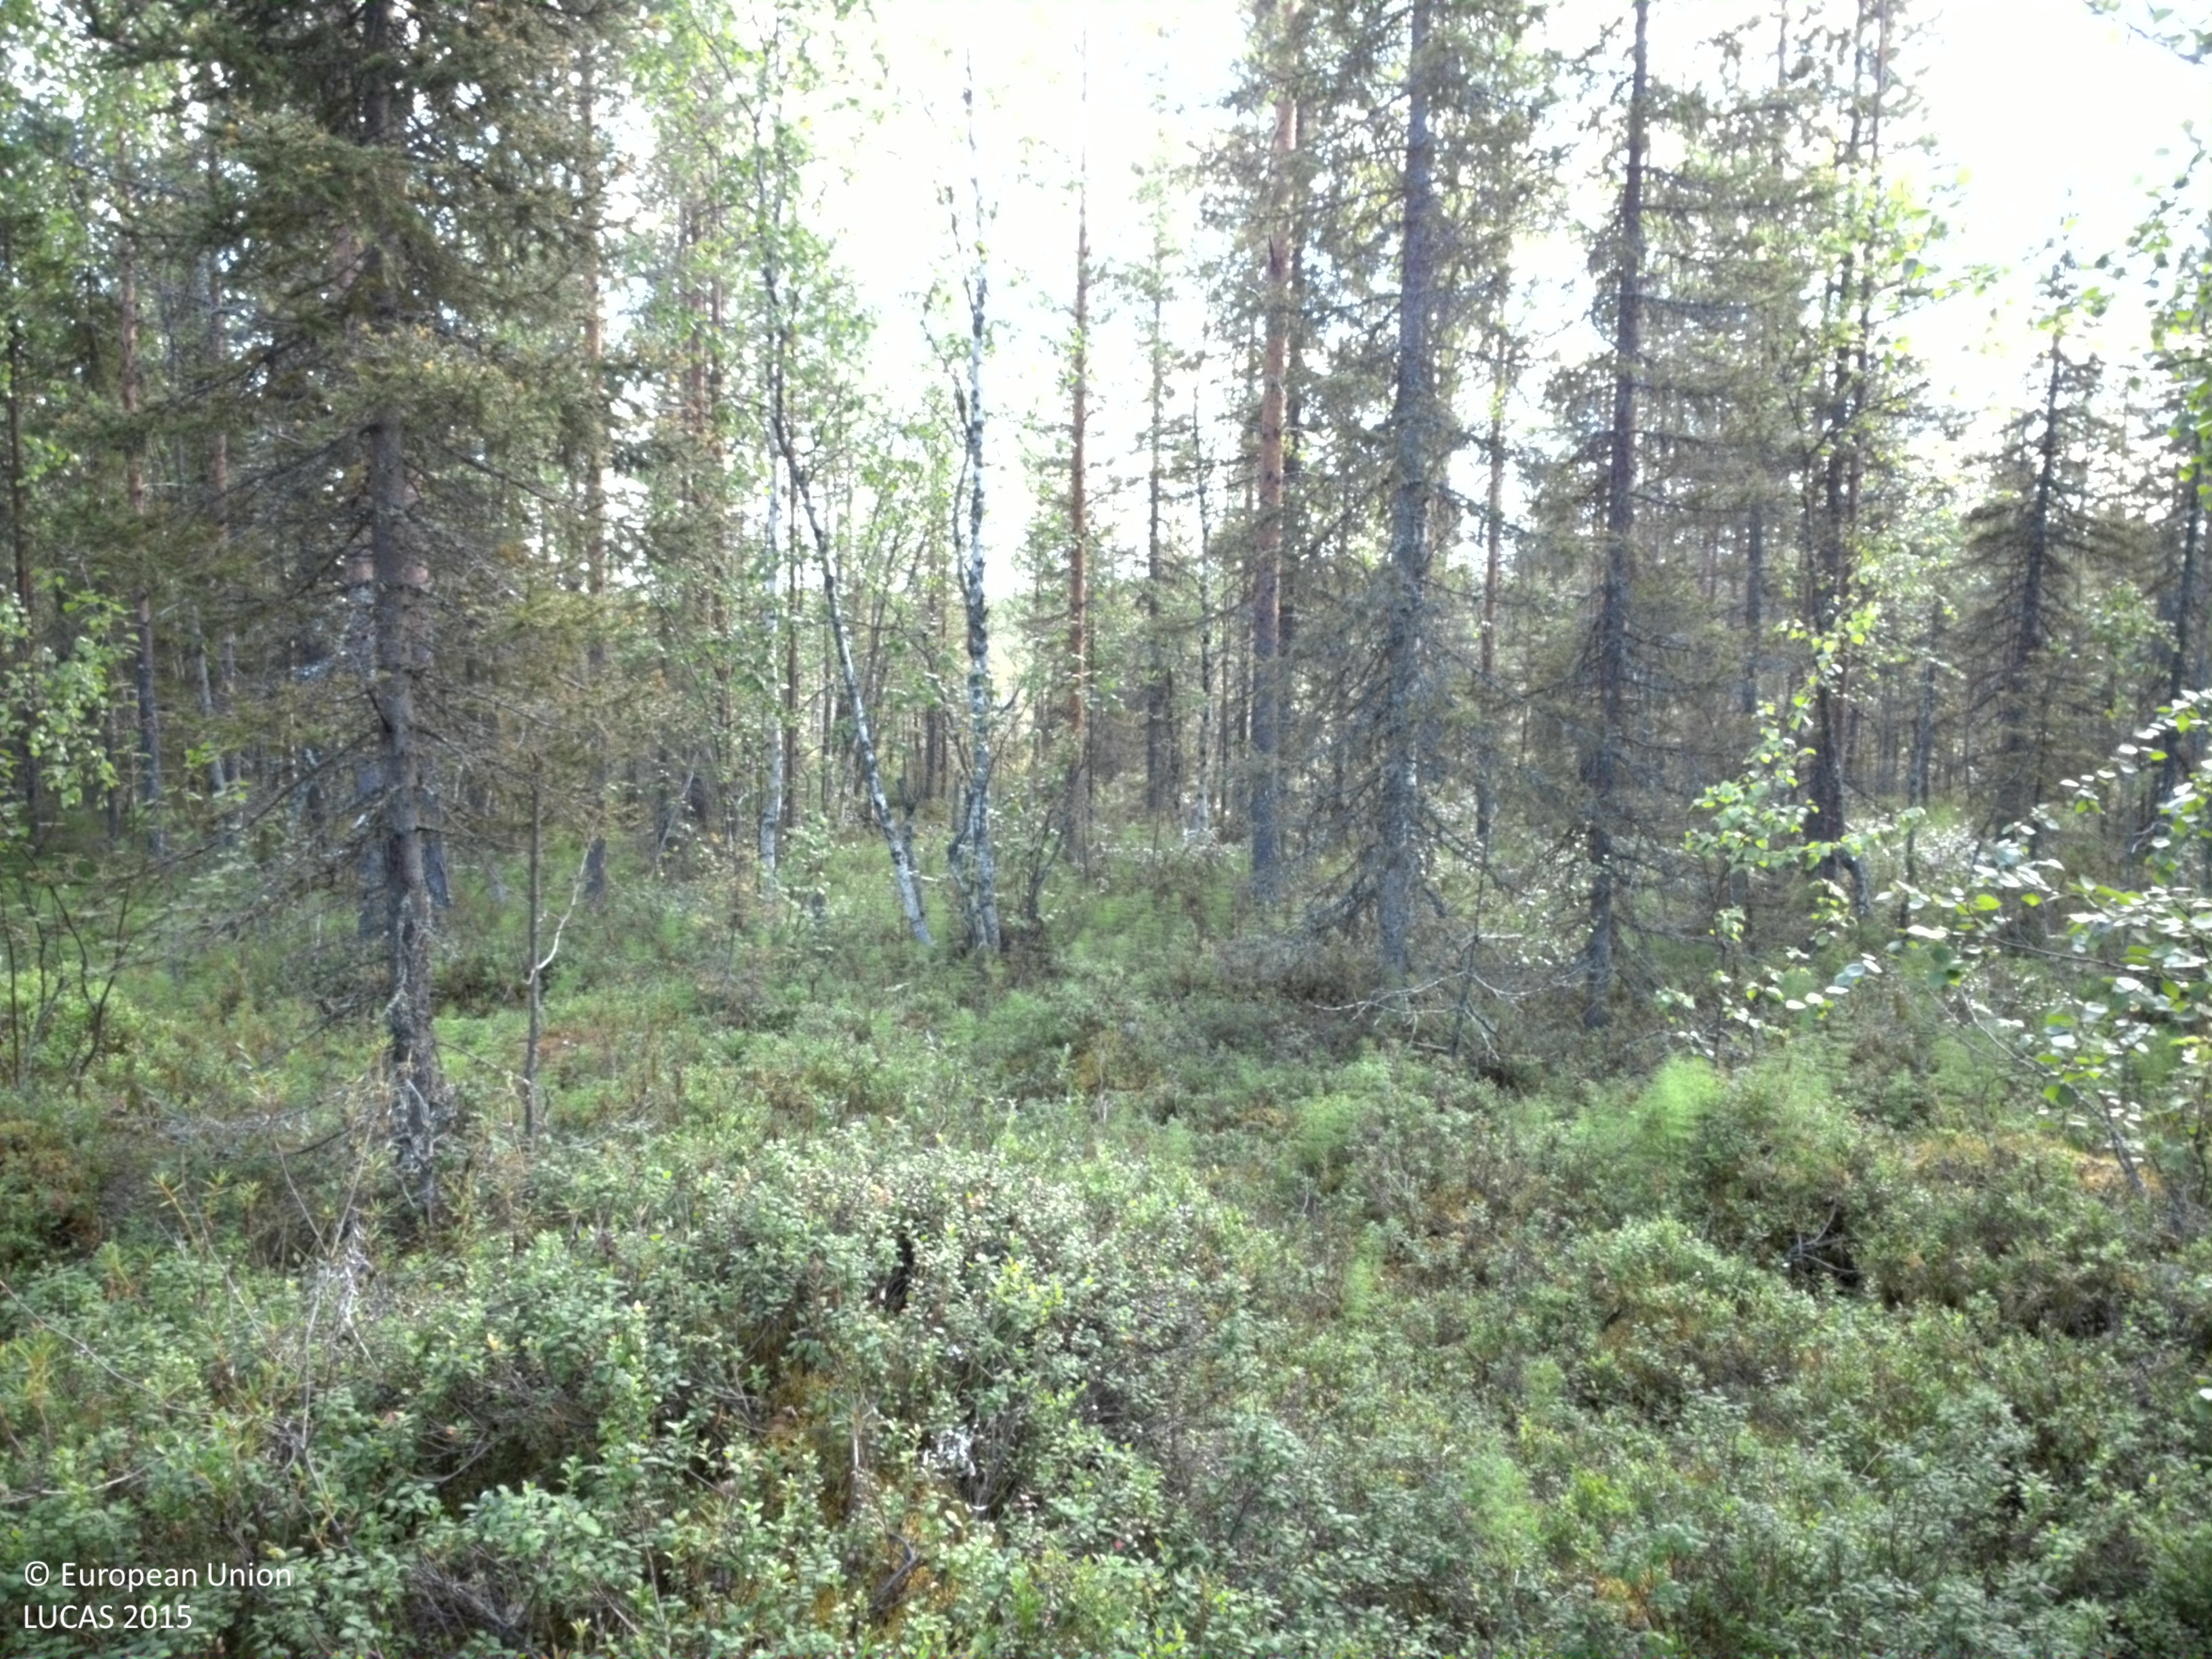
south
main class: Woodland
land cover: Pine dominated mixed woodland
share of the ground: 25 - 50 %
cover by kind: shrubs 60 %, coniferous forest trees 25 %, broadleaved forest trees 10 %, lichens and mosses 5 %
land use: Forestry
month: August
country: SE
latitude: 66.4247
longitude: 20.7809
